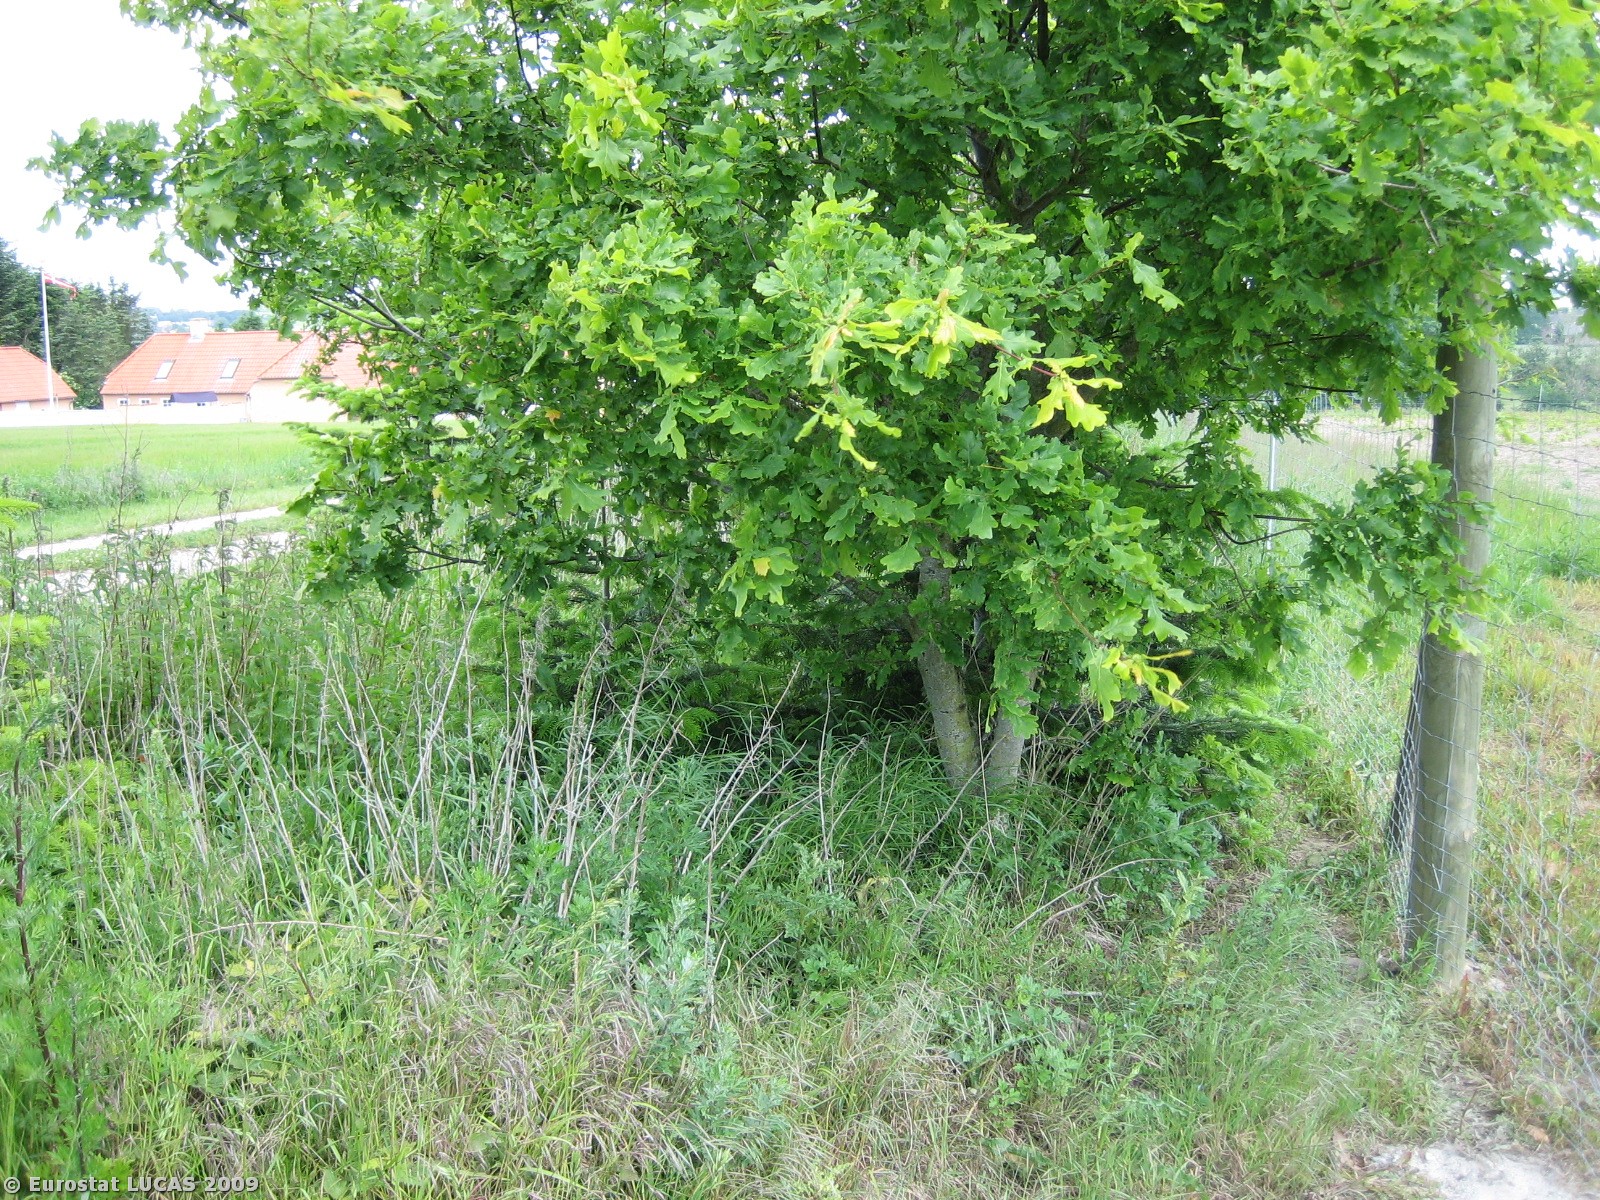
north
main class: Woodland
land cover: Coniferous woodland
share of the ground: 10 - 25 %
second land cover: Bare land
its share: > 75 %
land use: Agriculture (excluding fallow land and kitchen gardens)
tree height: < 5 m
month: June
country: DK
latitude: 55.8638
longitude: 9.6967
